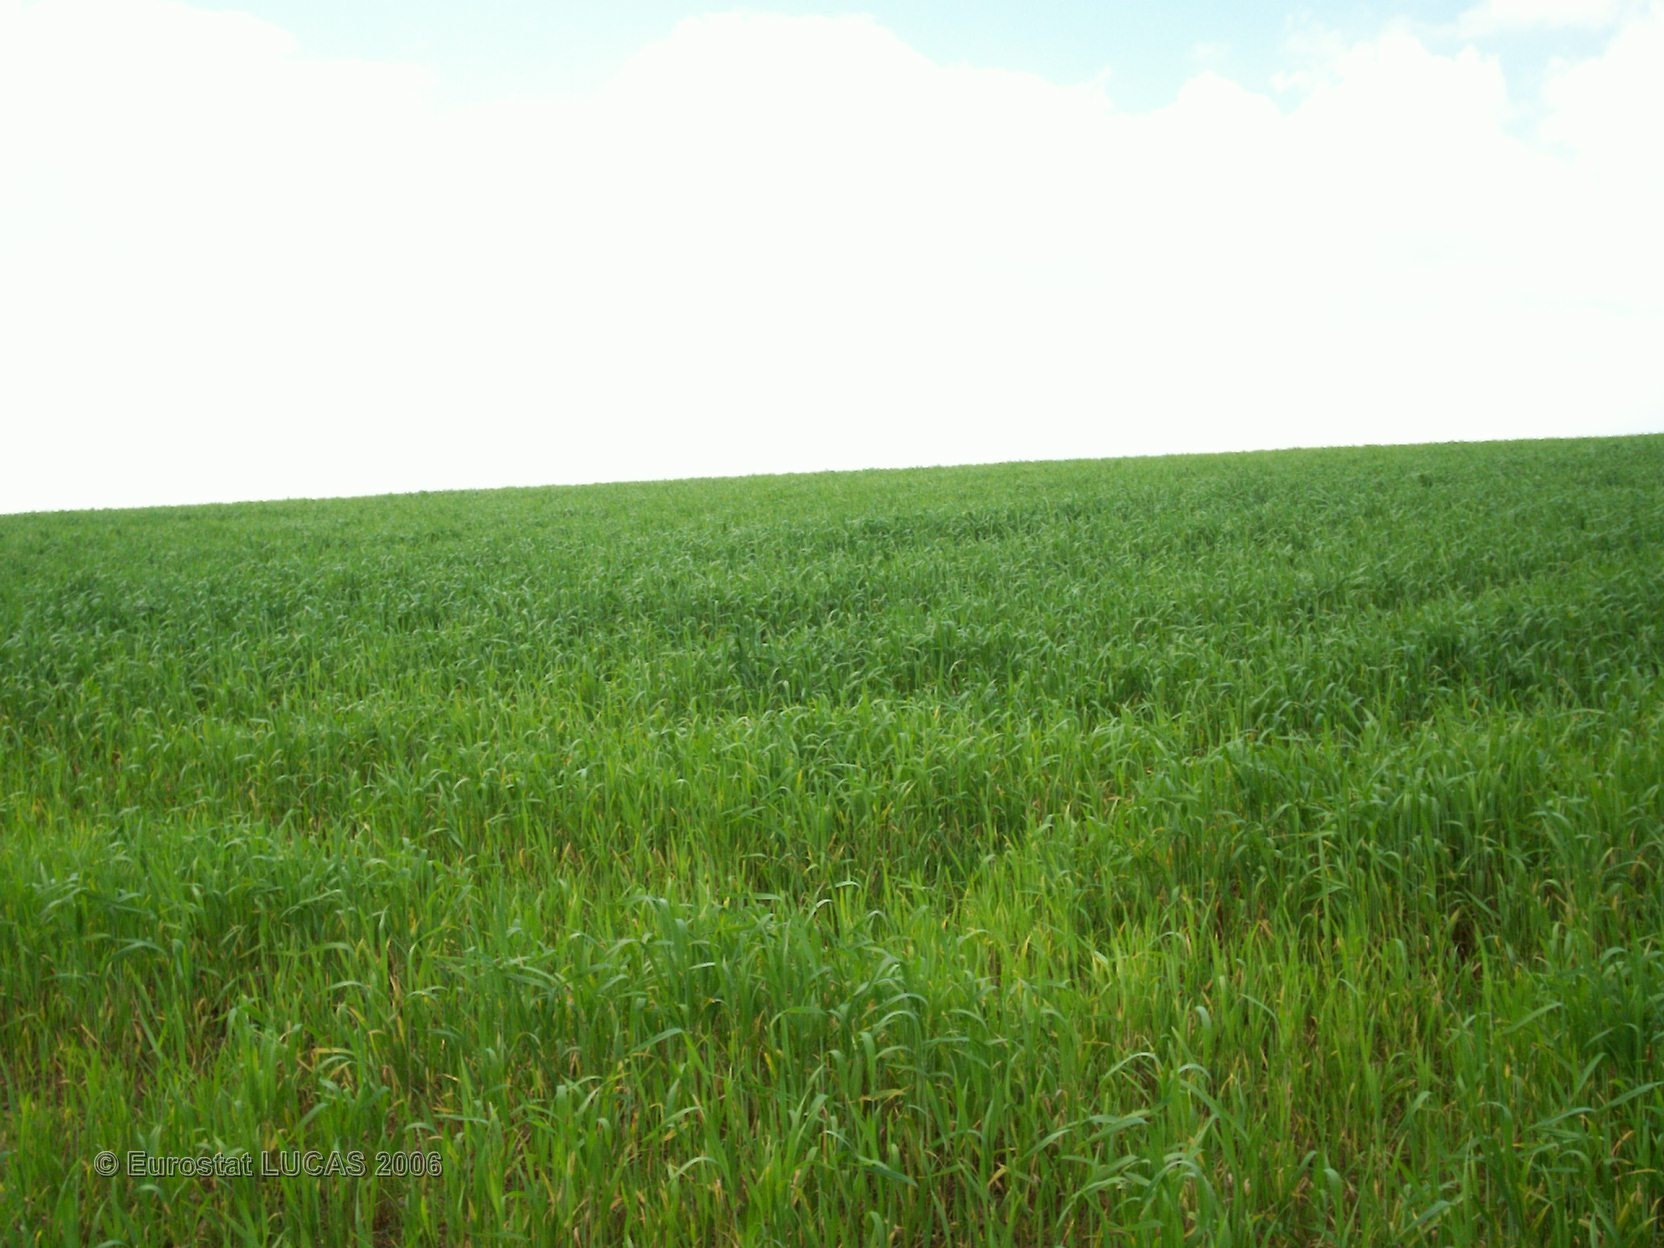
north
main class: Cropland
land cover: Barley
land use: Agriculture (excluding fallow land and kitchen gardens)
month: May
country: FR
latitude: 48.3909
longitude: -3.6537
